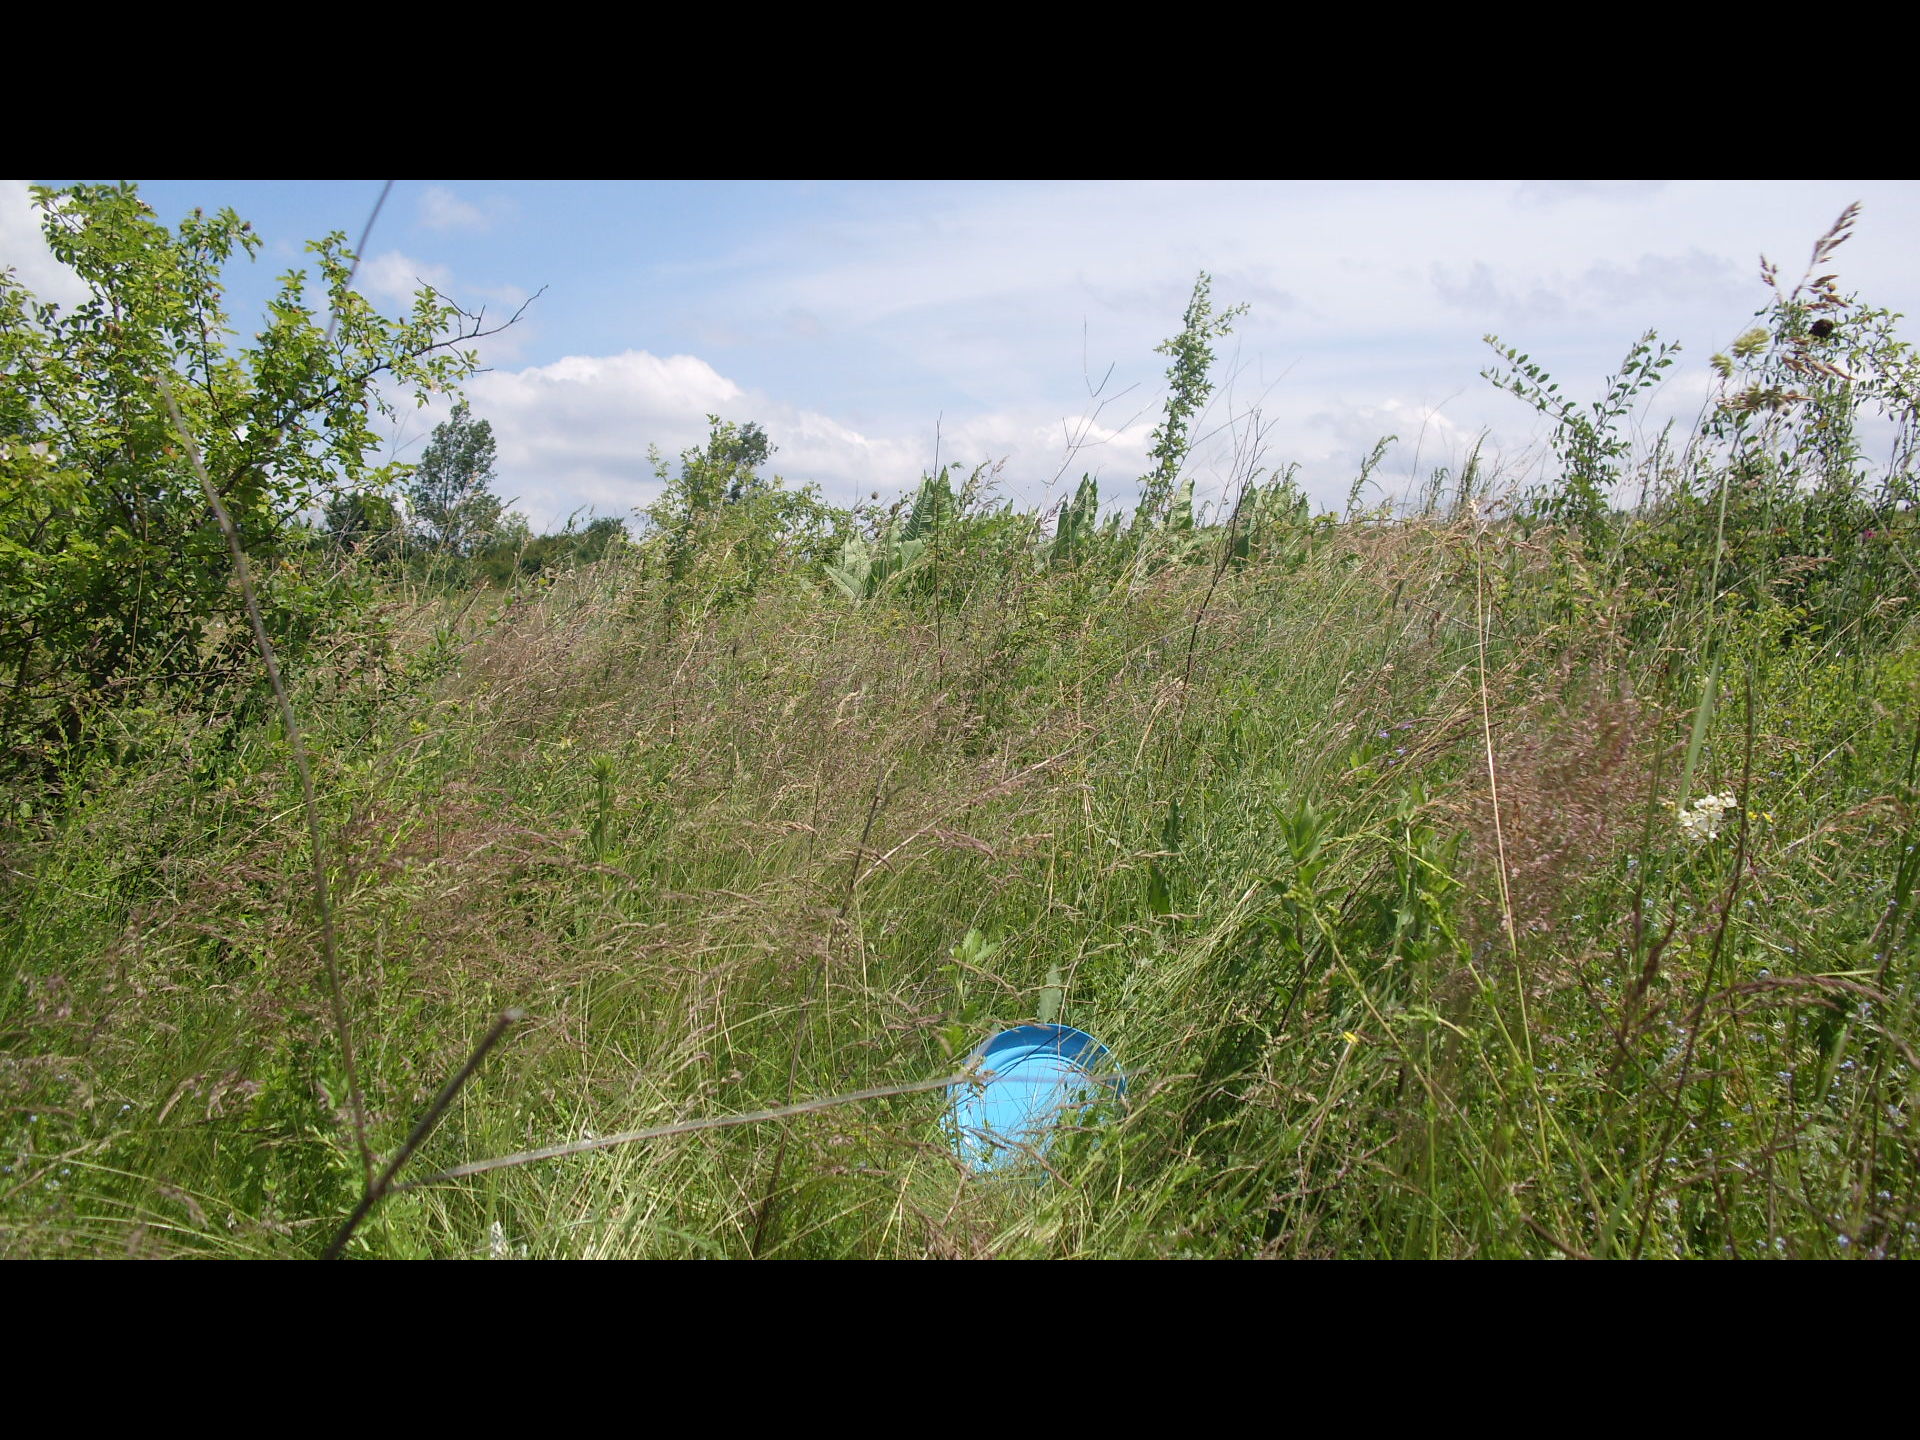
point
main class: Grassland
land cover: Grassland with sparse tree/shrub cover
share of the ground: > 75 %
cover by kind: herbaceous plants 90 %, broadleaved forest trees 5 %, shrubs 5 %
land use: Semi-natural and natural areas not in use
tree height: < 5 m
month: May
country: BG
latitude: 43.3697
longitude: 23.3822
